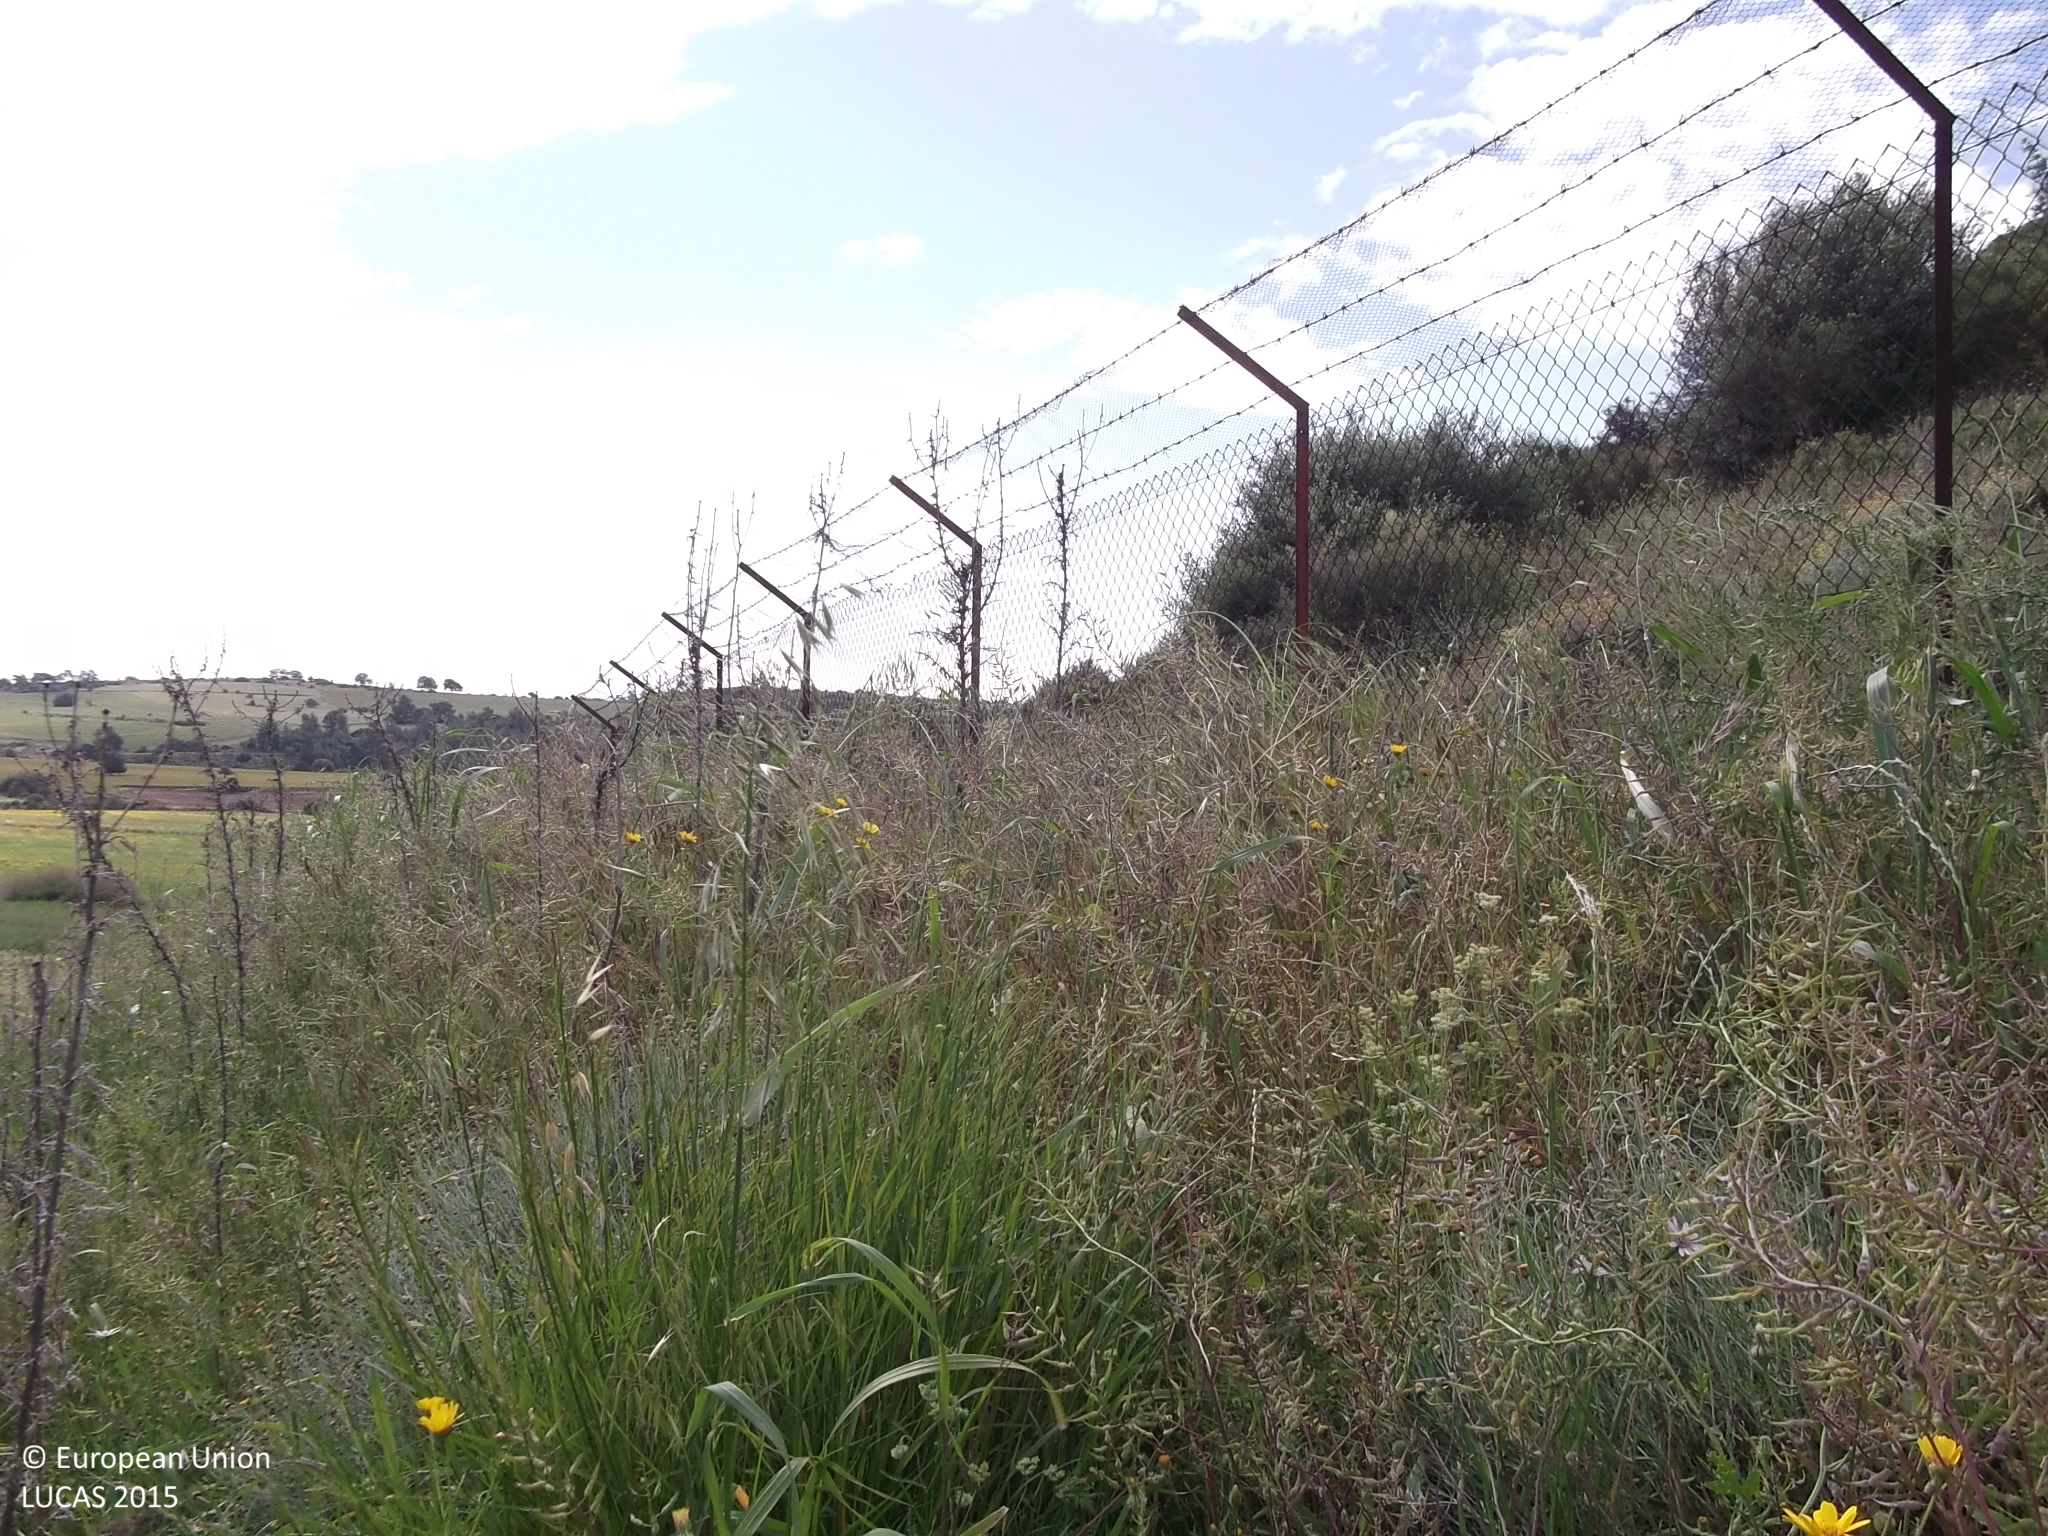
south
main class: Shrubland
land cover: Shrubland without tree cover
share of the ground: > 75 %
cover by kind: shrubs 80 %, herbaceous plants 20 %
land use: Semi-natural and natural areas not in use
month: April
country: CY
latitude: 34.8352
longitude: 33.4217
